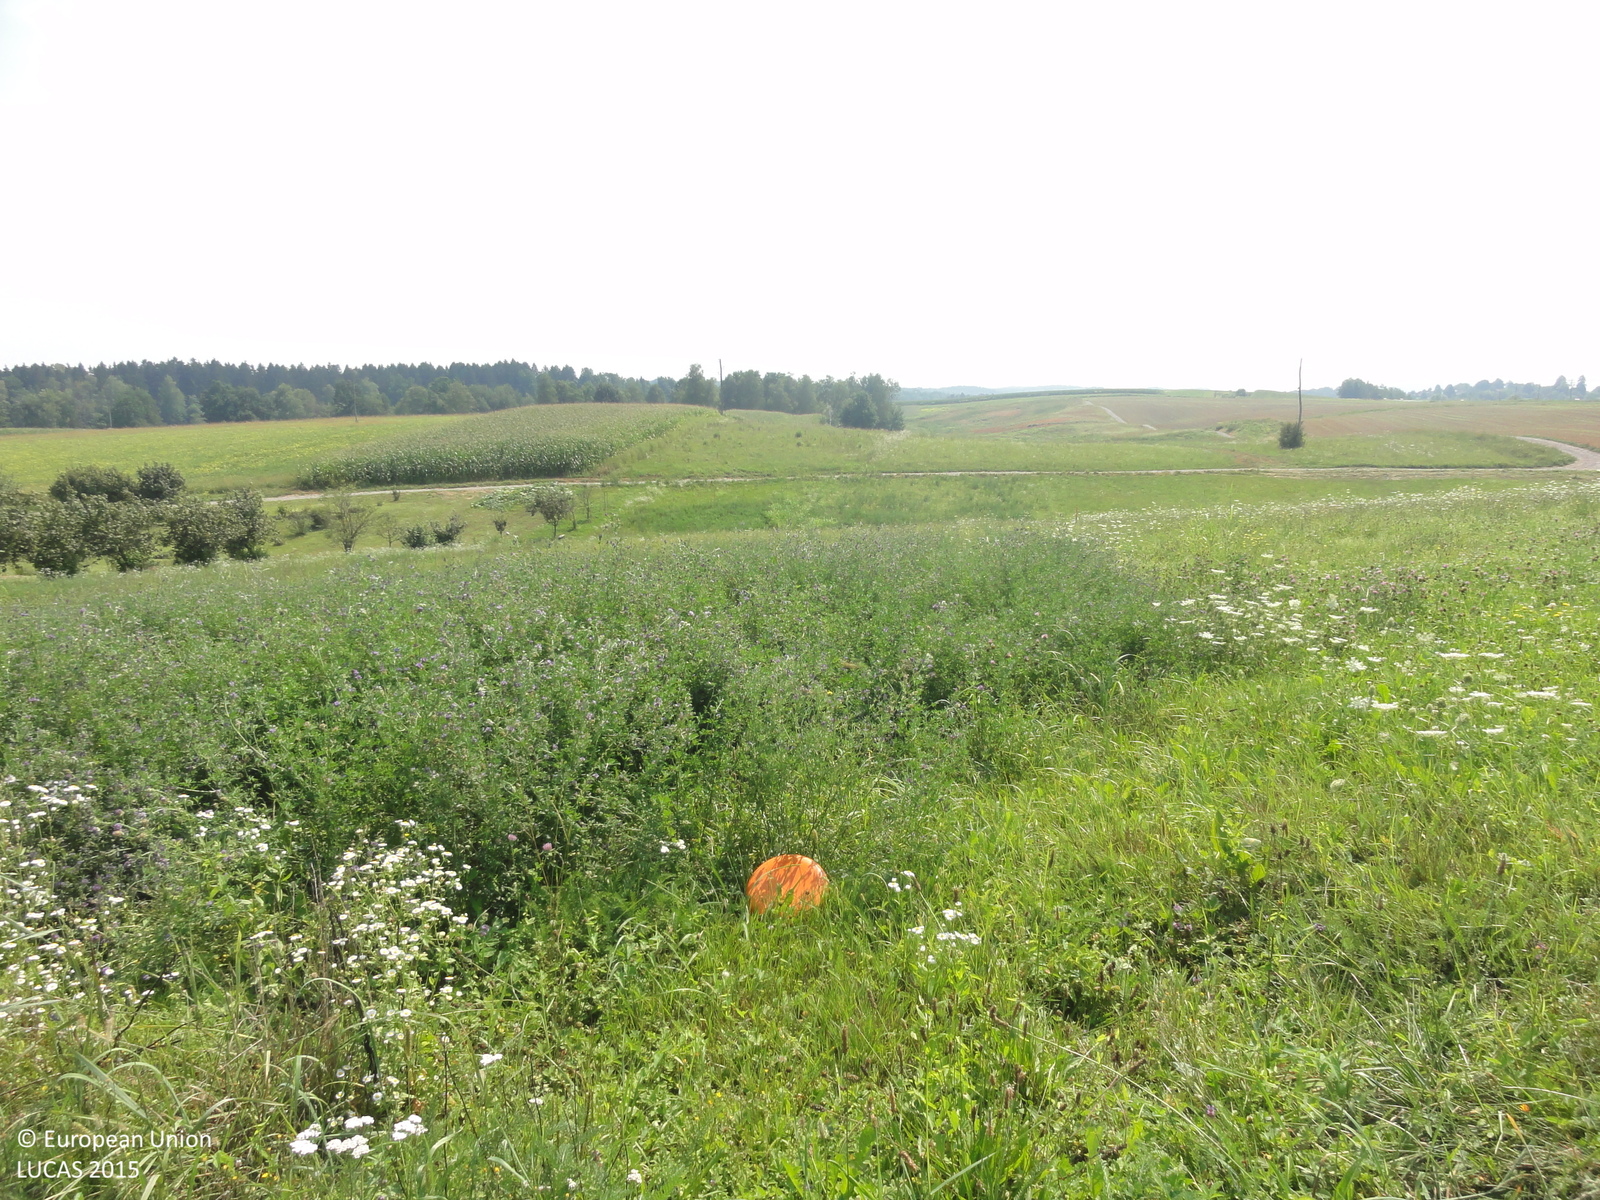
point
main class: Cropland
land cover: Lucerne
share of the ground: > 75 %
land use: Agriculture (excluding fallow land and kitchen gardens)
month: August
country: SI
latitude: 45.5217
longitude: 15.1809
